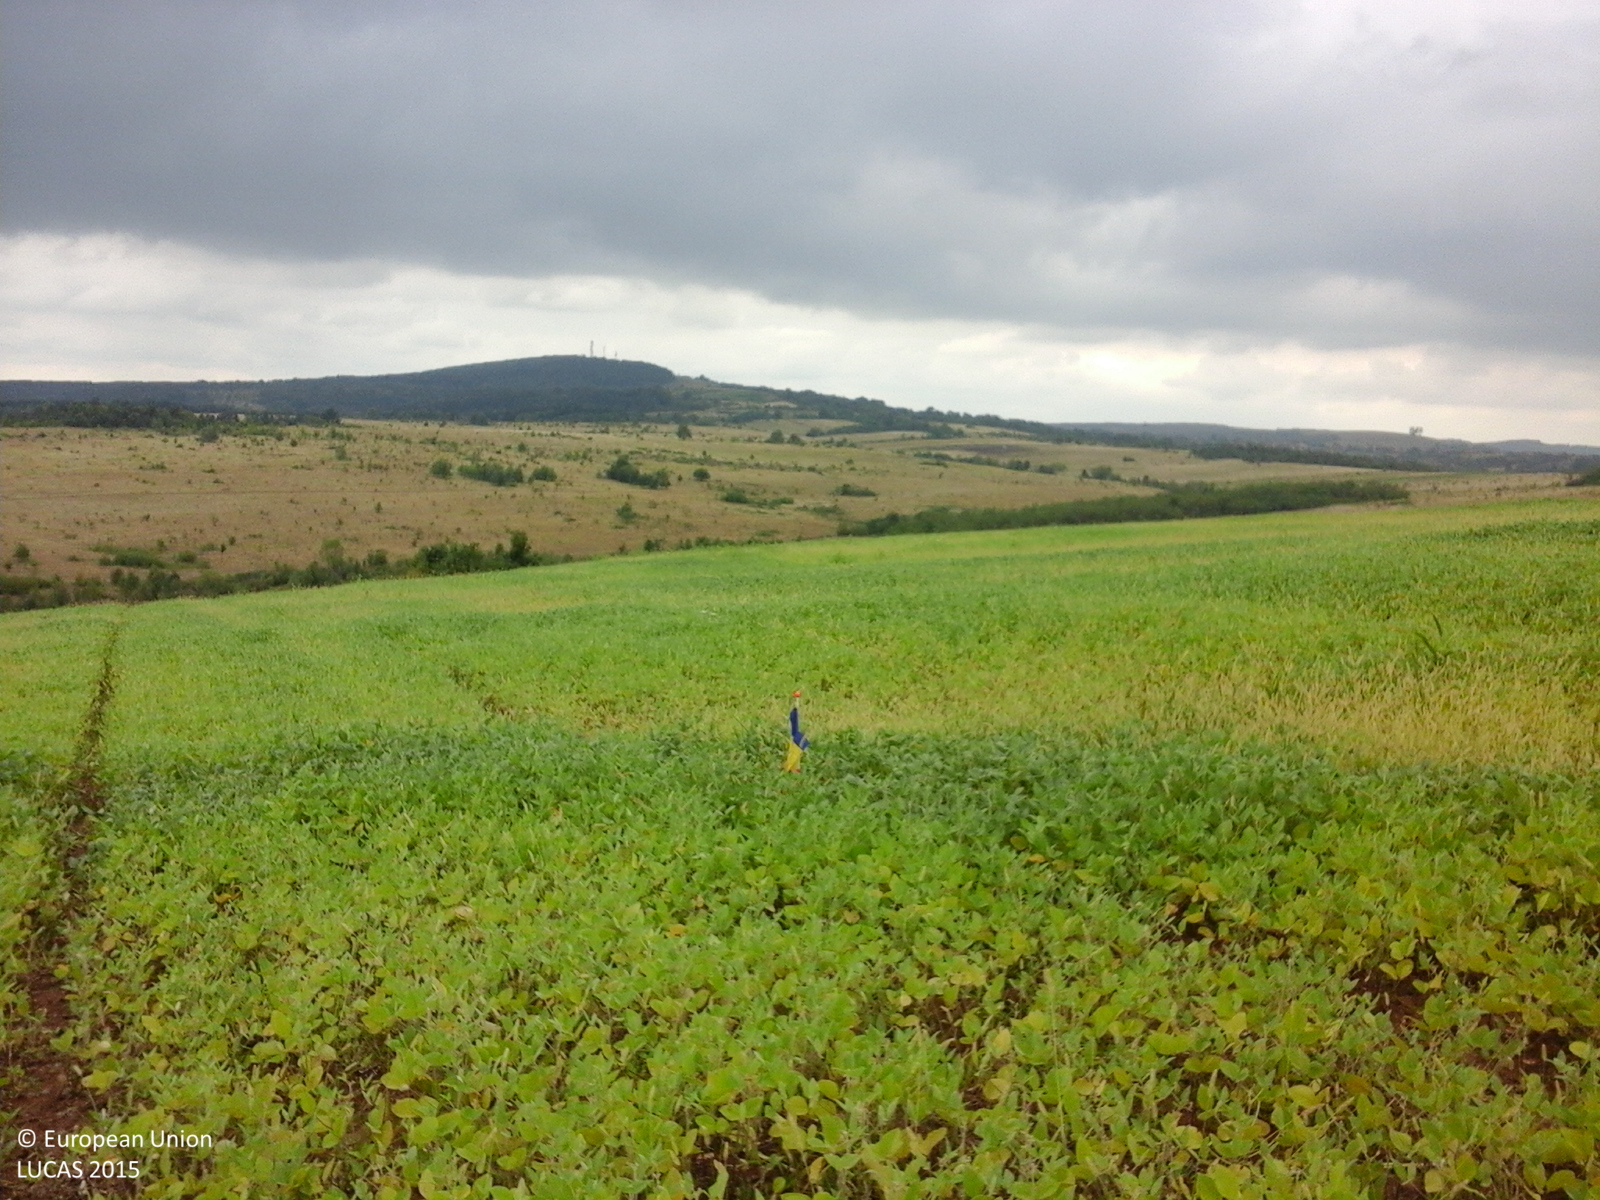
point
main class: Cropland
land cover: Soya
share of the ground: > 75 %
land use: Agriculture (excluding fallow land and kitchen gardens)
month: August
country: RO
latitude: 45.5725
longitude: 21.7608
